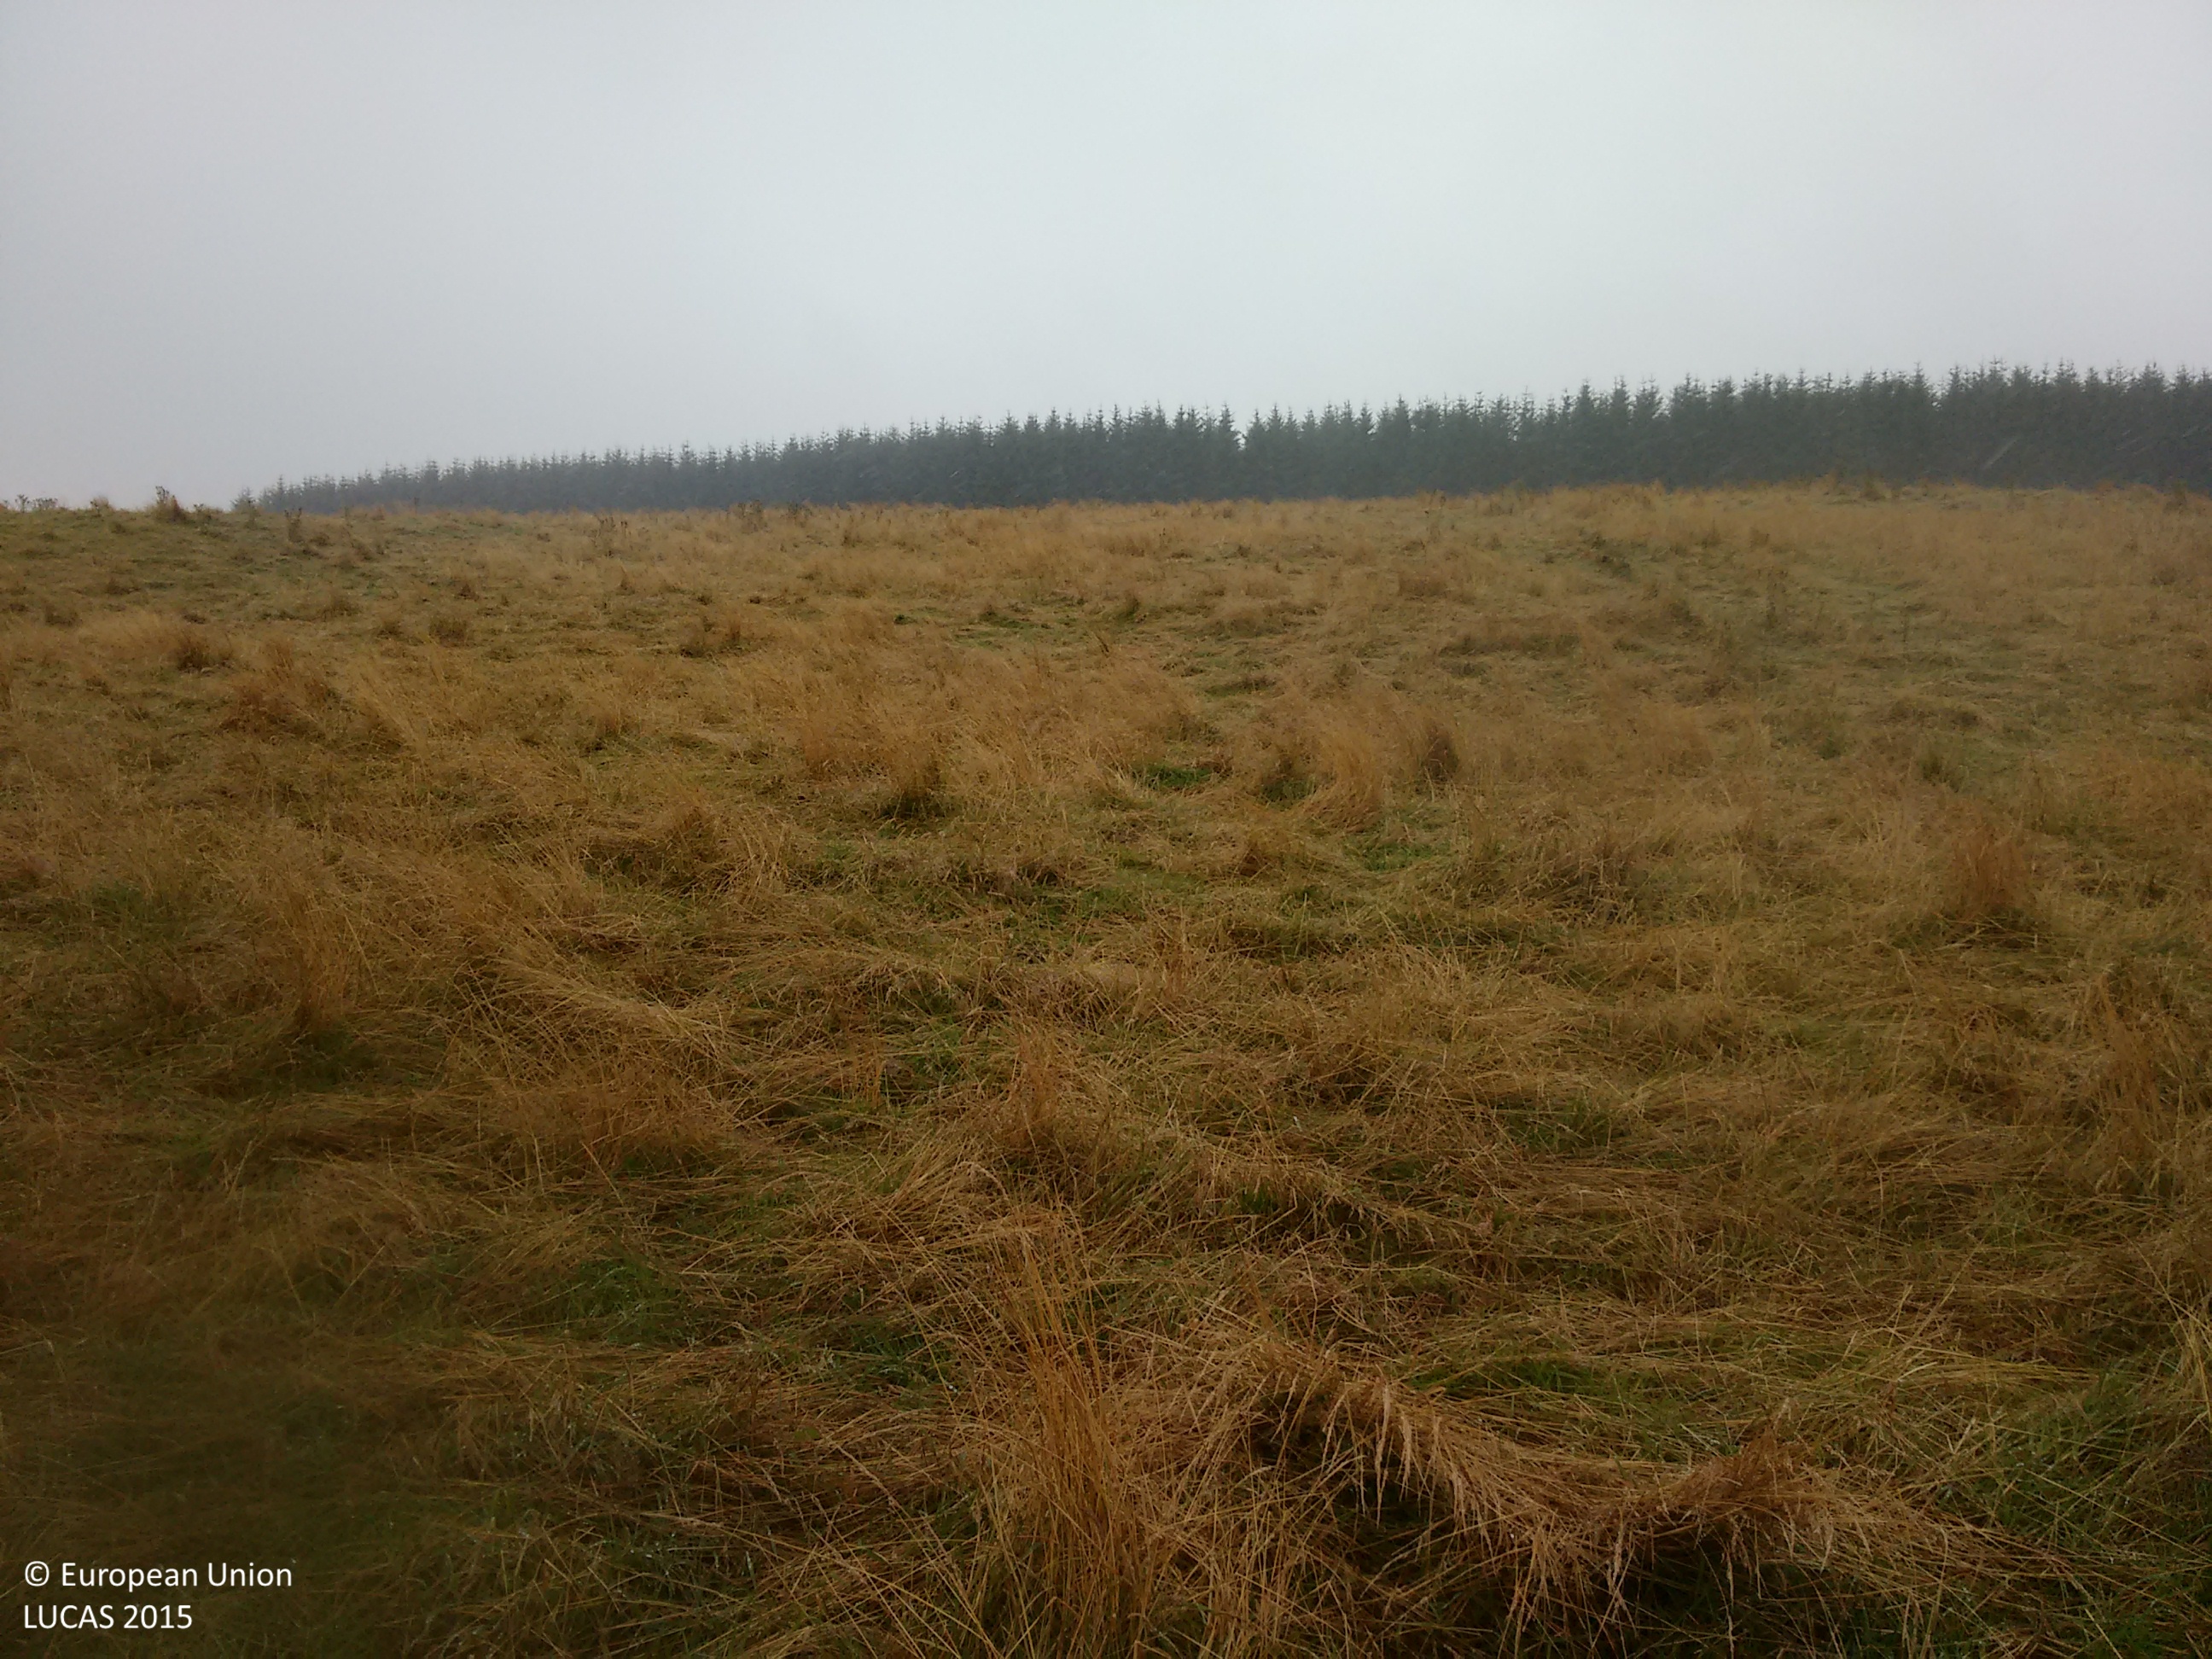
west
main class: Grassland
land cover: Grassland without tree/shrub cover
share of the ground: > 75 %
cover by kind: herbaceous plants 100 %
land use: Agriculture (excluding fallow land and kitchen gardens)
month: September
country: GB
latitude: 57.5985
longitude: -2.8584
